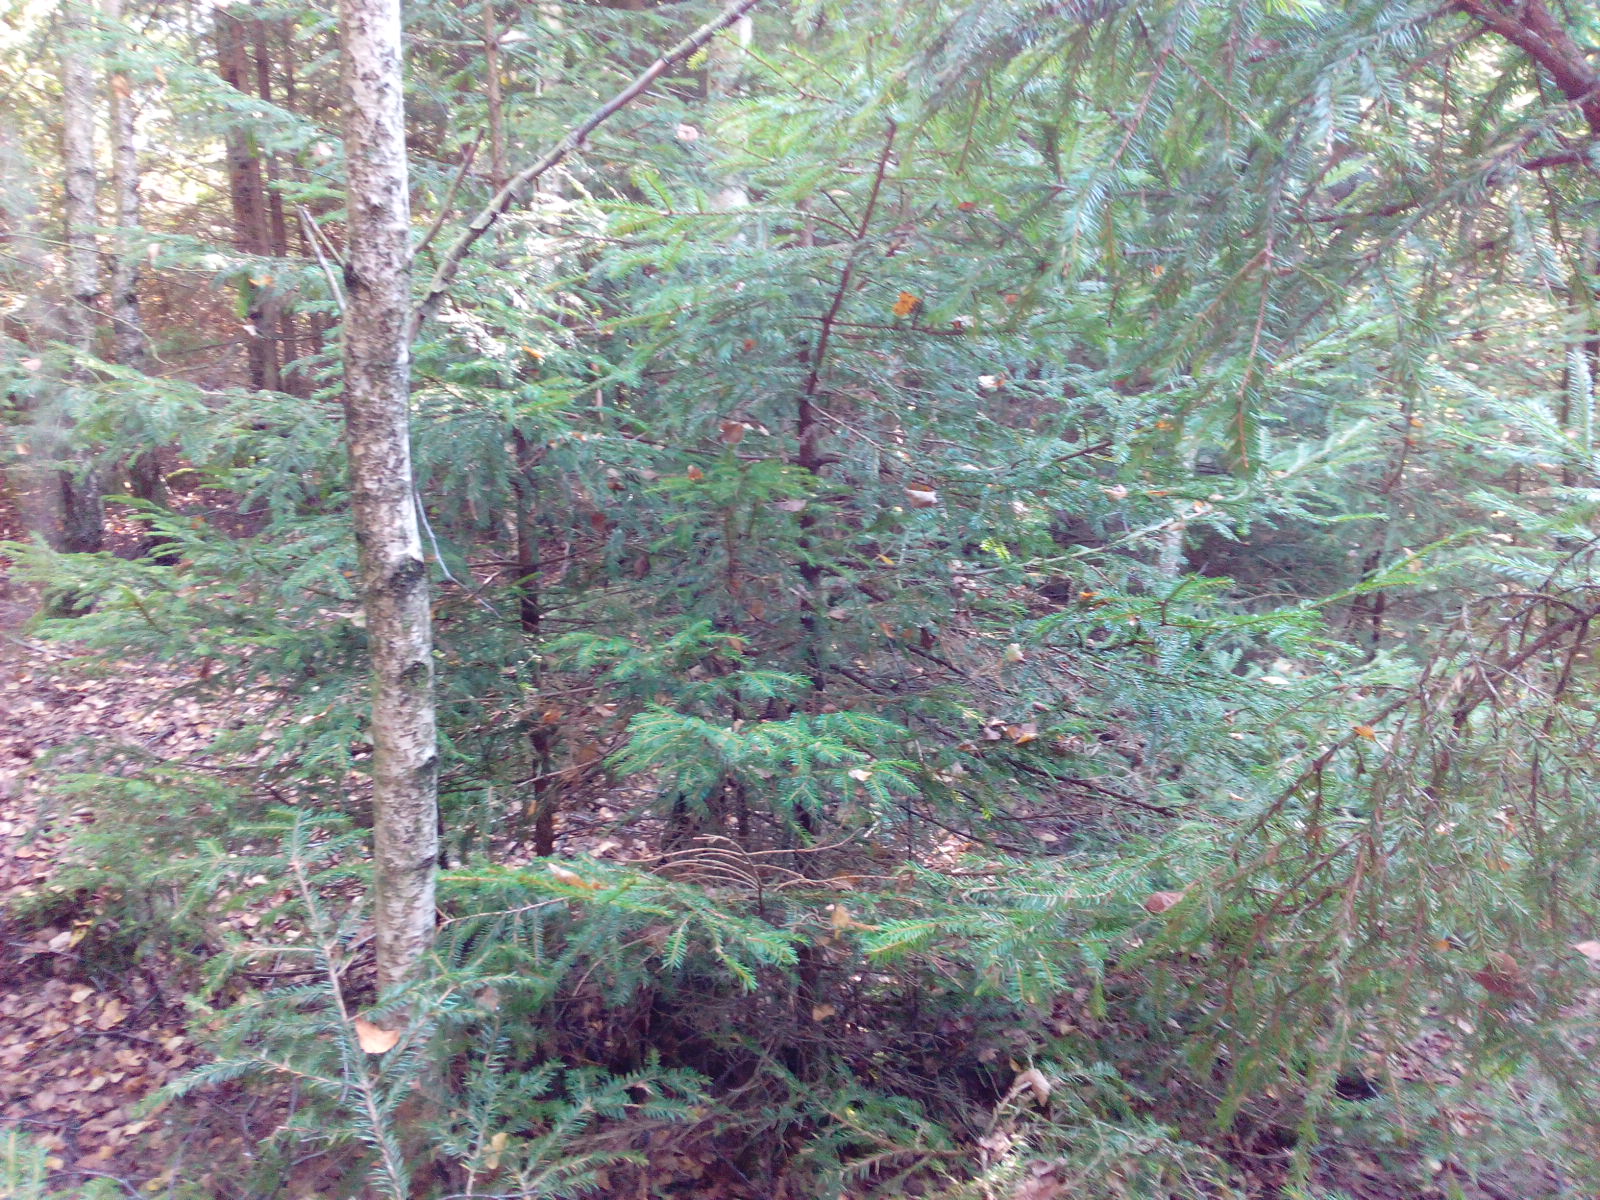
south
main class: Woodland
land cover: Other mixed woodland
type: hemiboreal forest and nemoral coniferous forest and mixed broadleaved-coniferous forest
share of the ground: > 75 %
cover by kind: coniferous forest trees 45 %, broadleaved forest trees 45 %, lichens and mosses 10 %
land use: Forestry
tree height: > 5 m
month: October
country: SE
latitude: 56.6000
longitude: 13.1080
